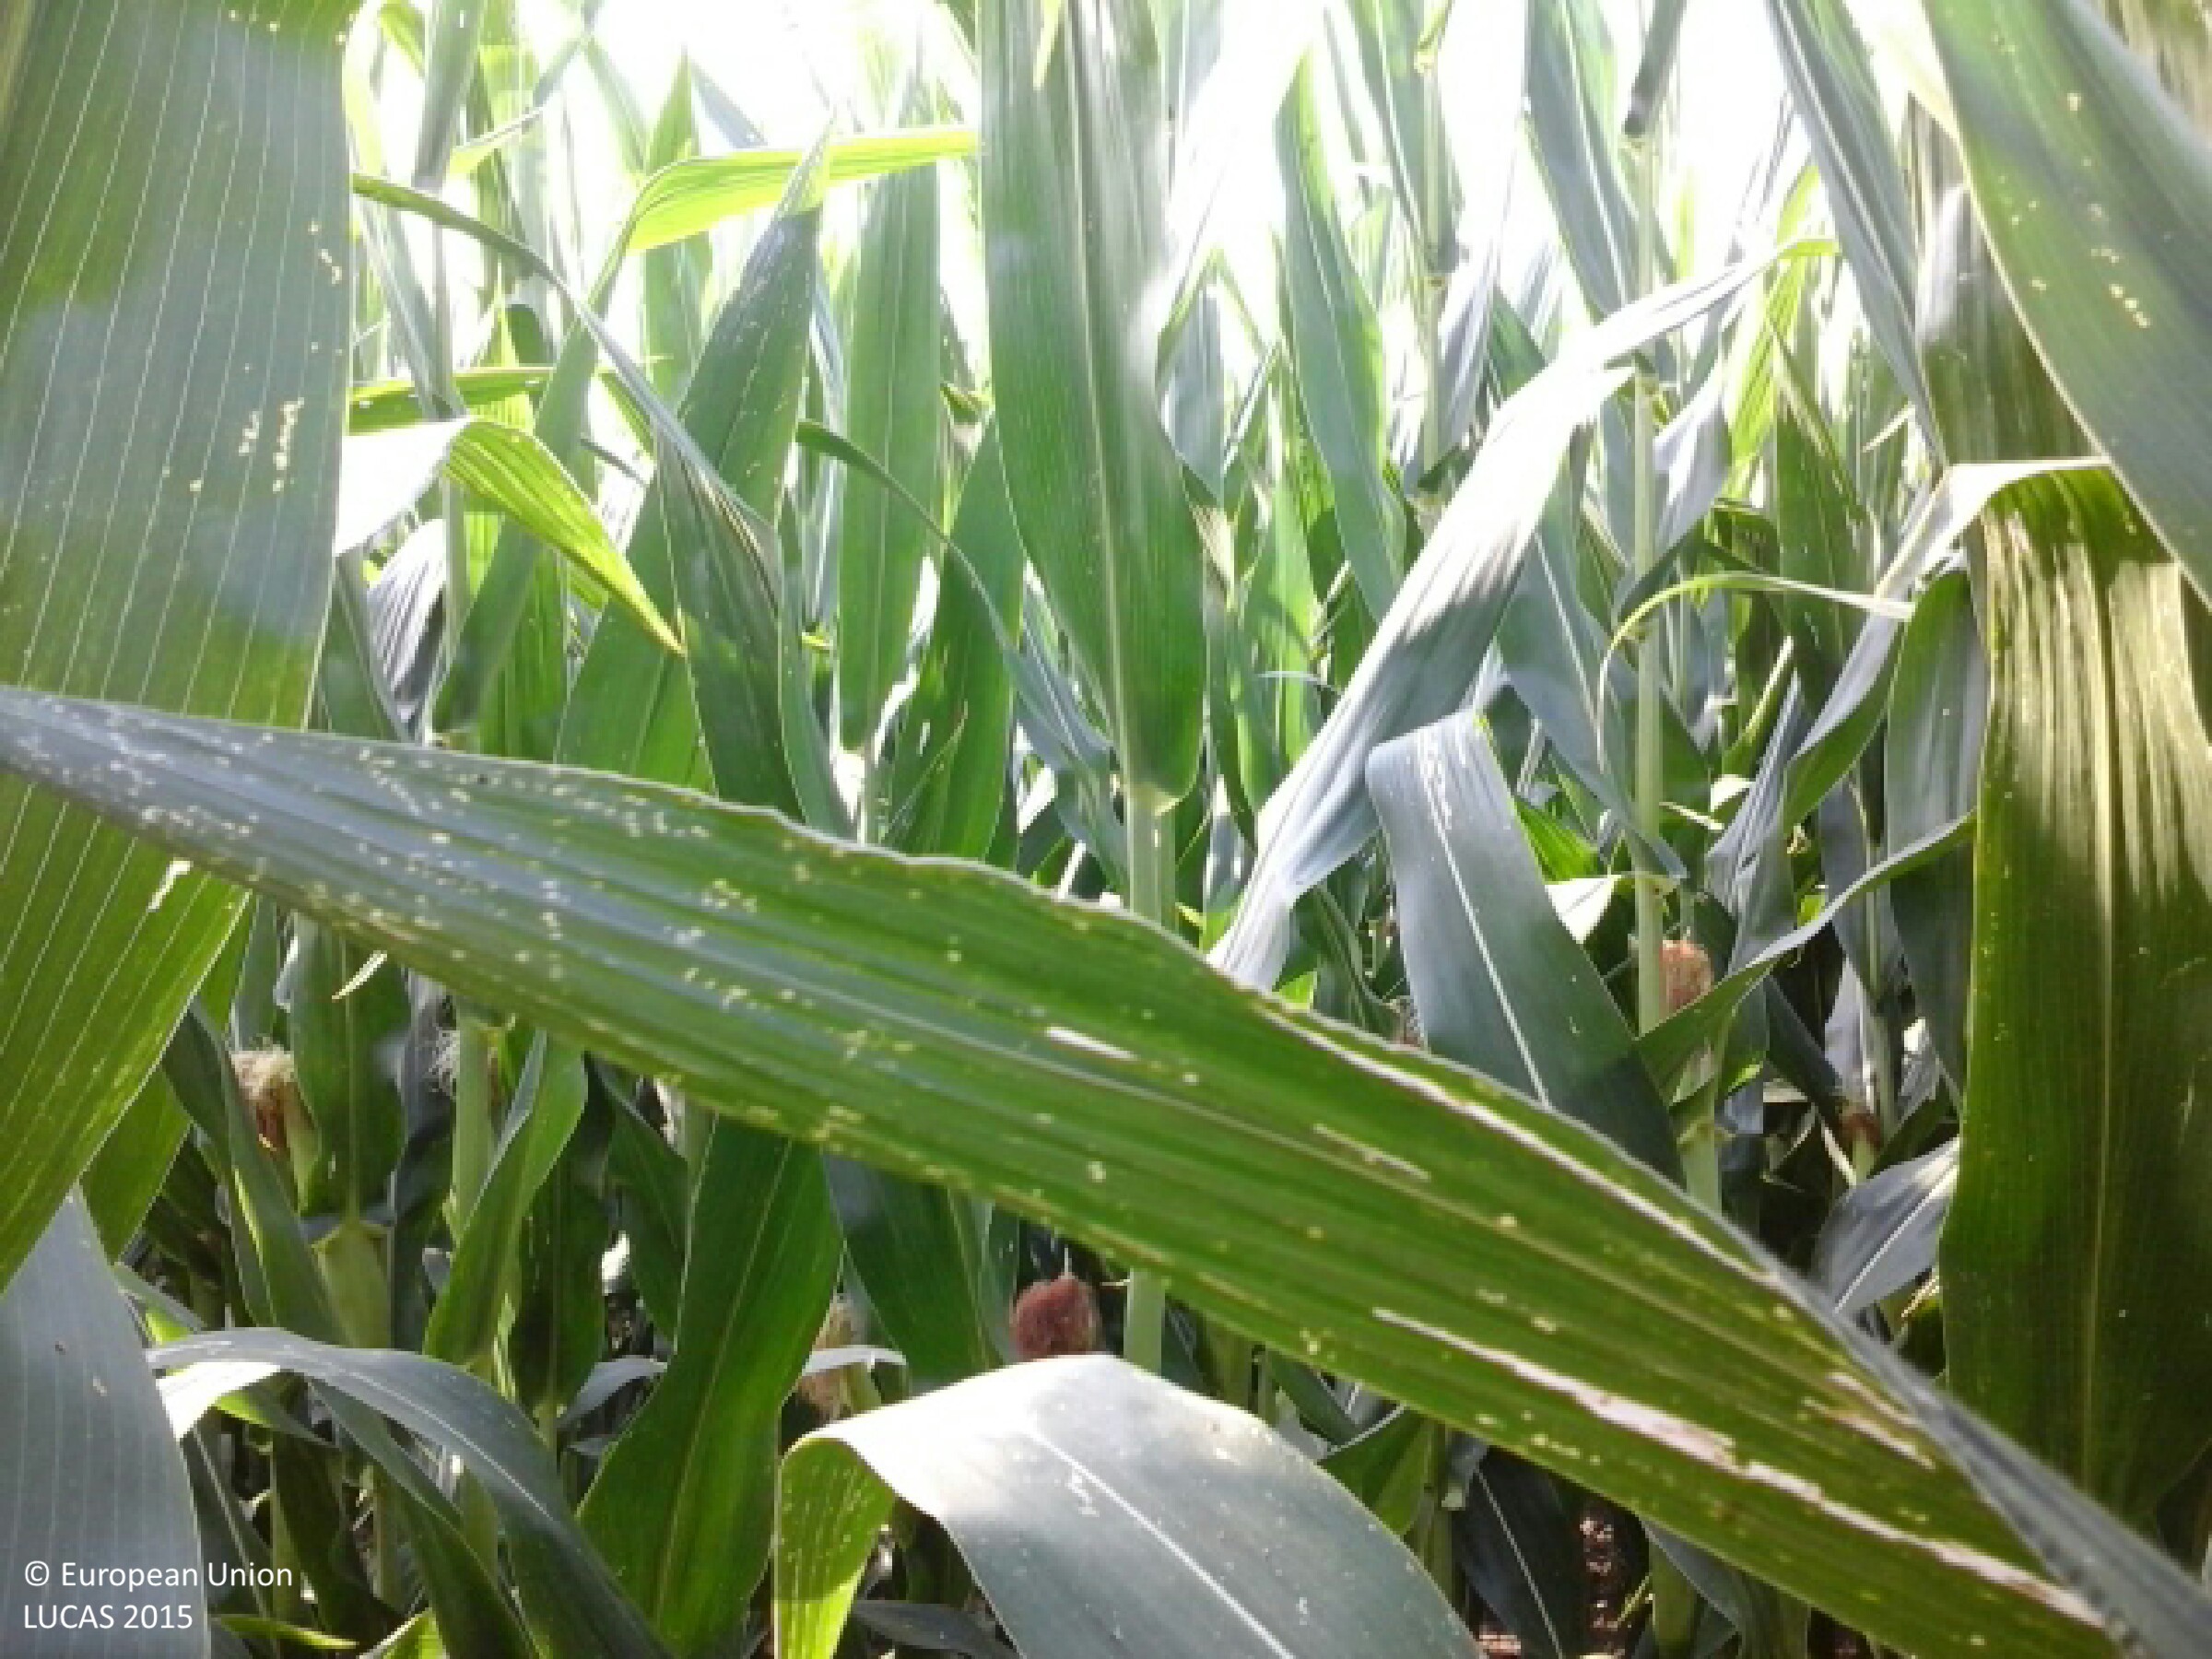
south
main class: Cropland
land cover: Maize
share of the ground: > 75 %
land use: Agriculture (excluding fallow land and kitchen gardens)
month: August
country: HU
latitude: 47.6839
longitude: 17.9373
